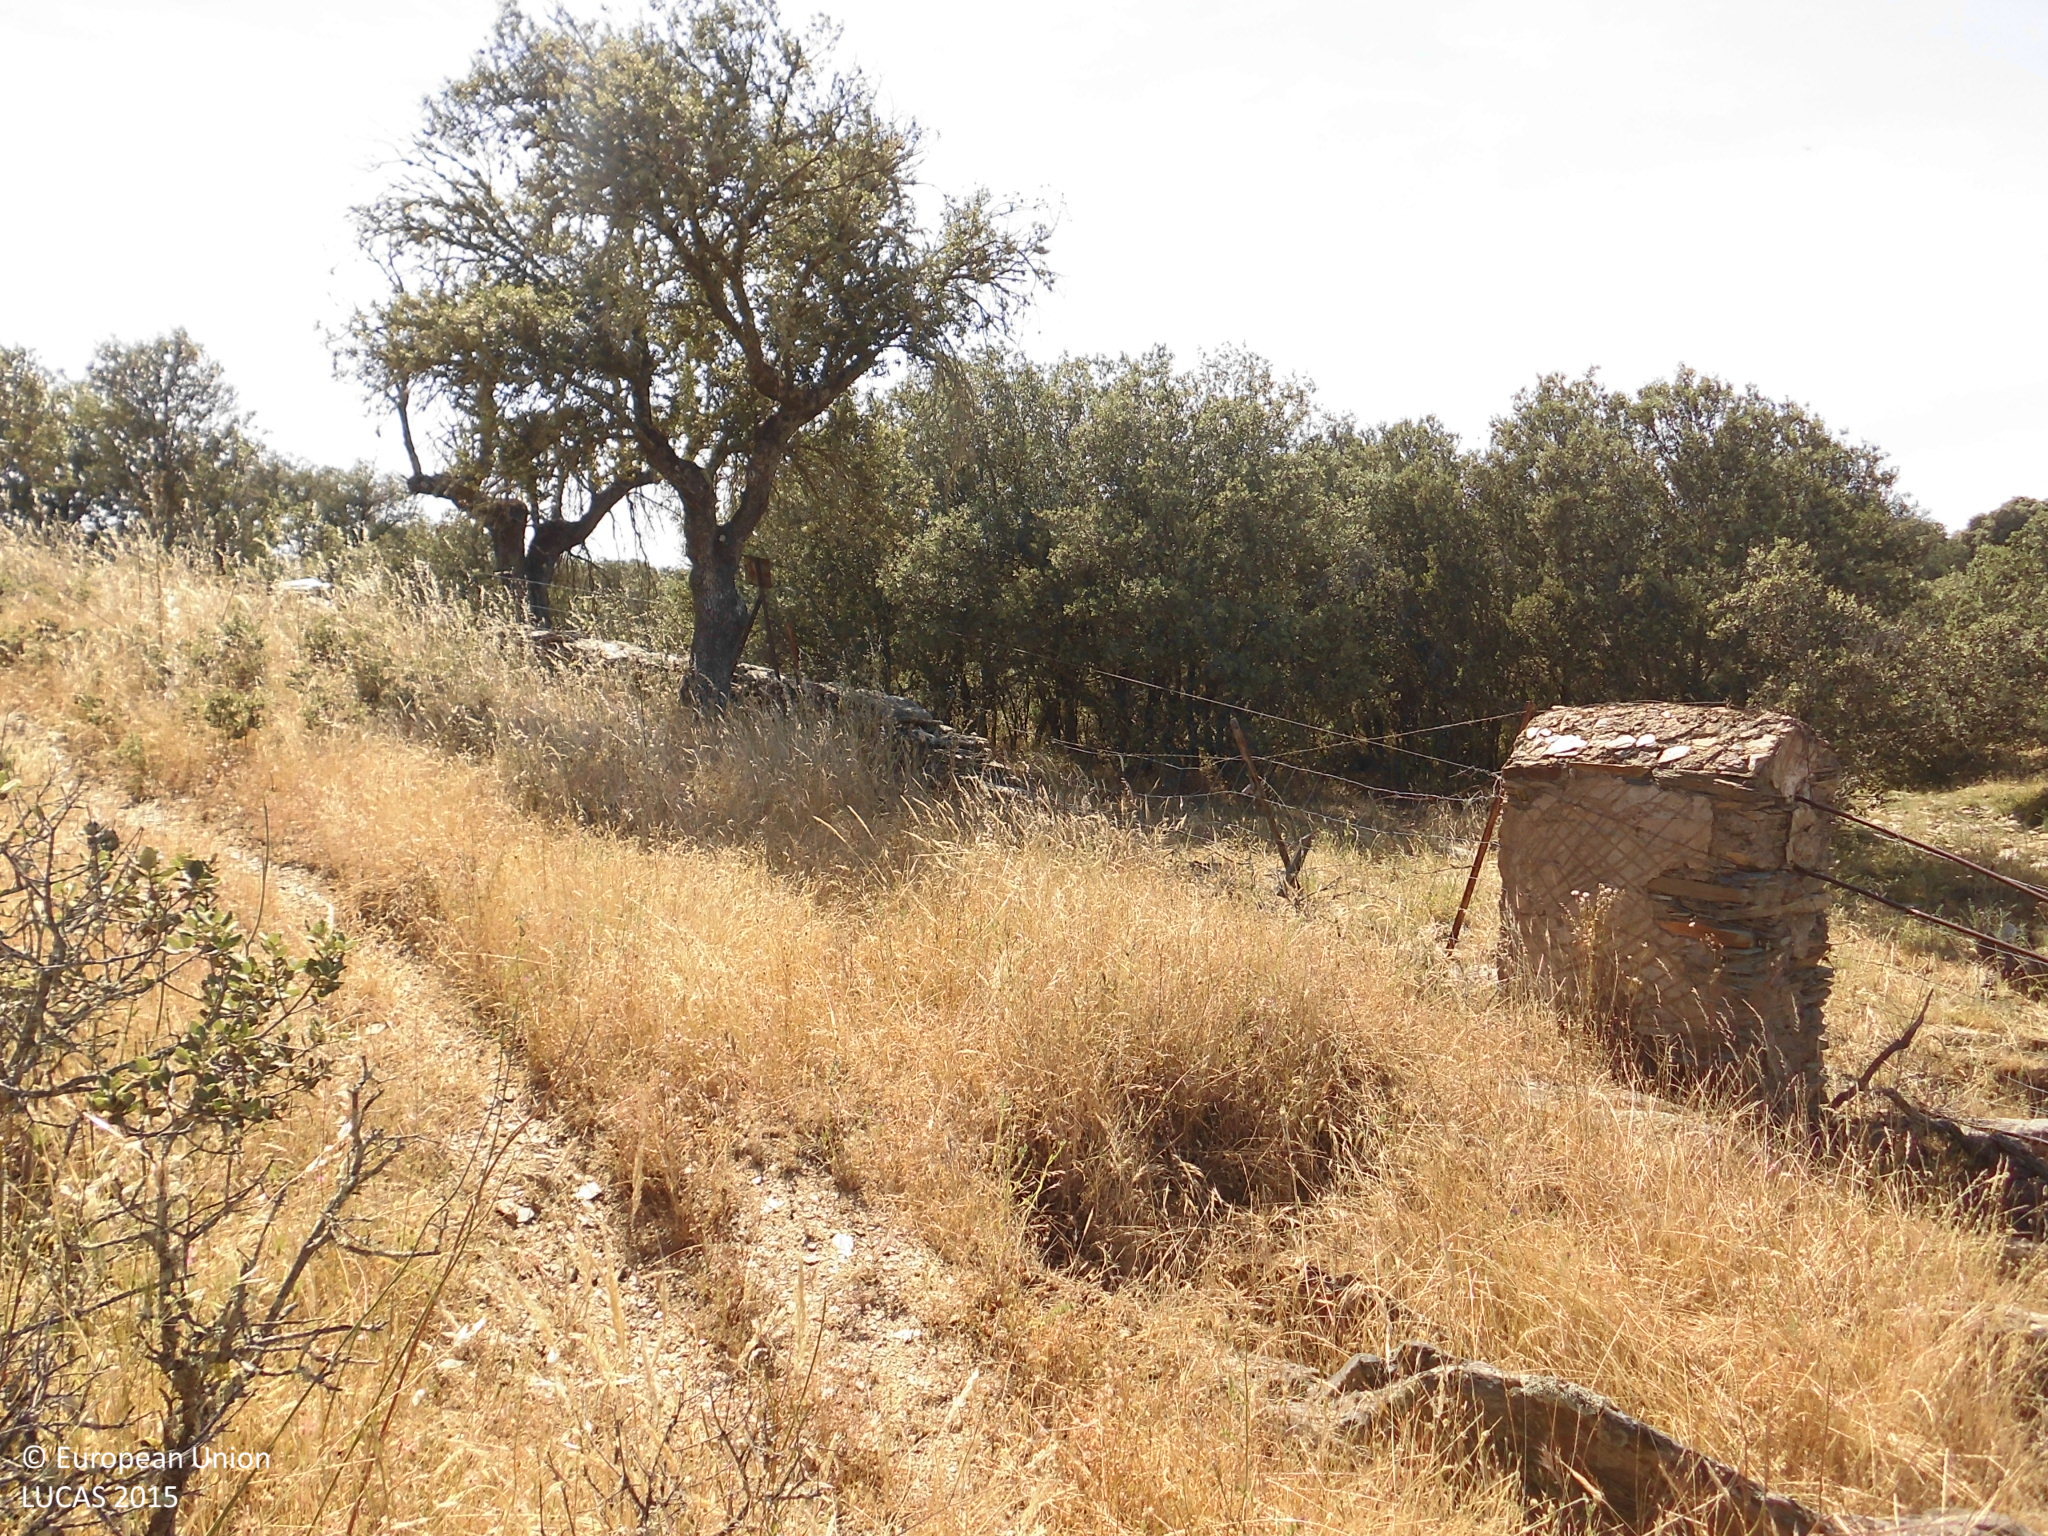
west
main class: Shrubland
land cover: Shrubland with sparse tree cover
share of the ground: 25 - 50 %
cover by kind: shrubs 40 %, herbaceous plants 30 %, unconsolidated bare surface 25 %, broadleaved forest trees 5 %
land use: Forestry
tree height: < 5 m
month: May
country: ES
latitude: 39.4532
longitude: -6.0402
